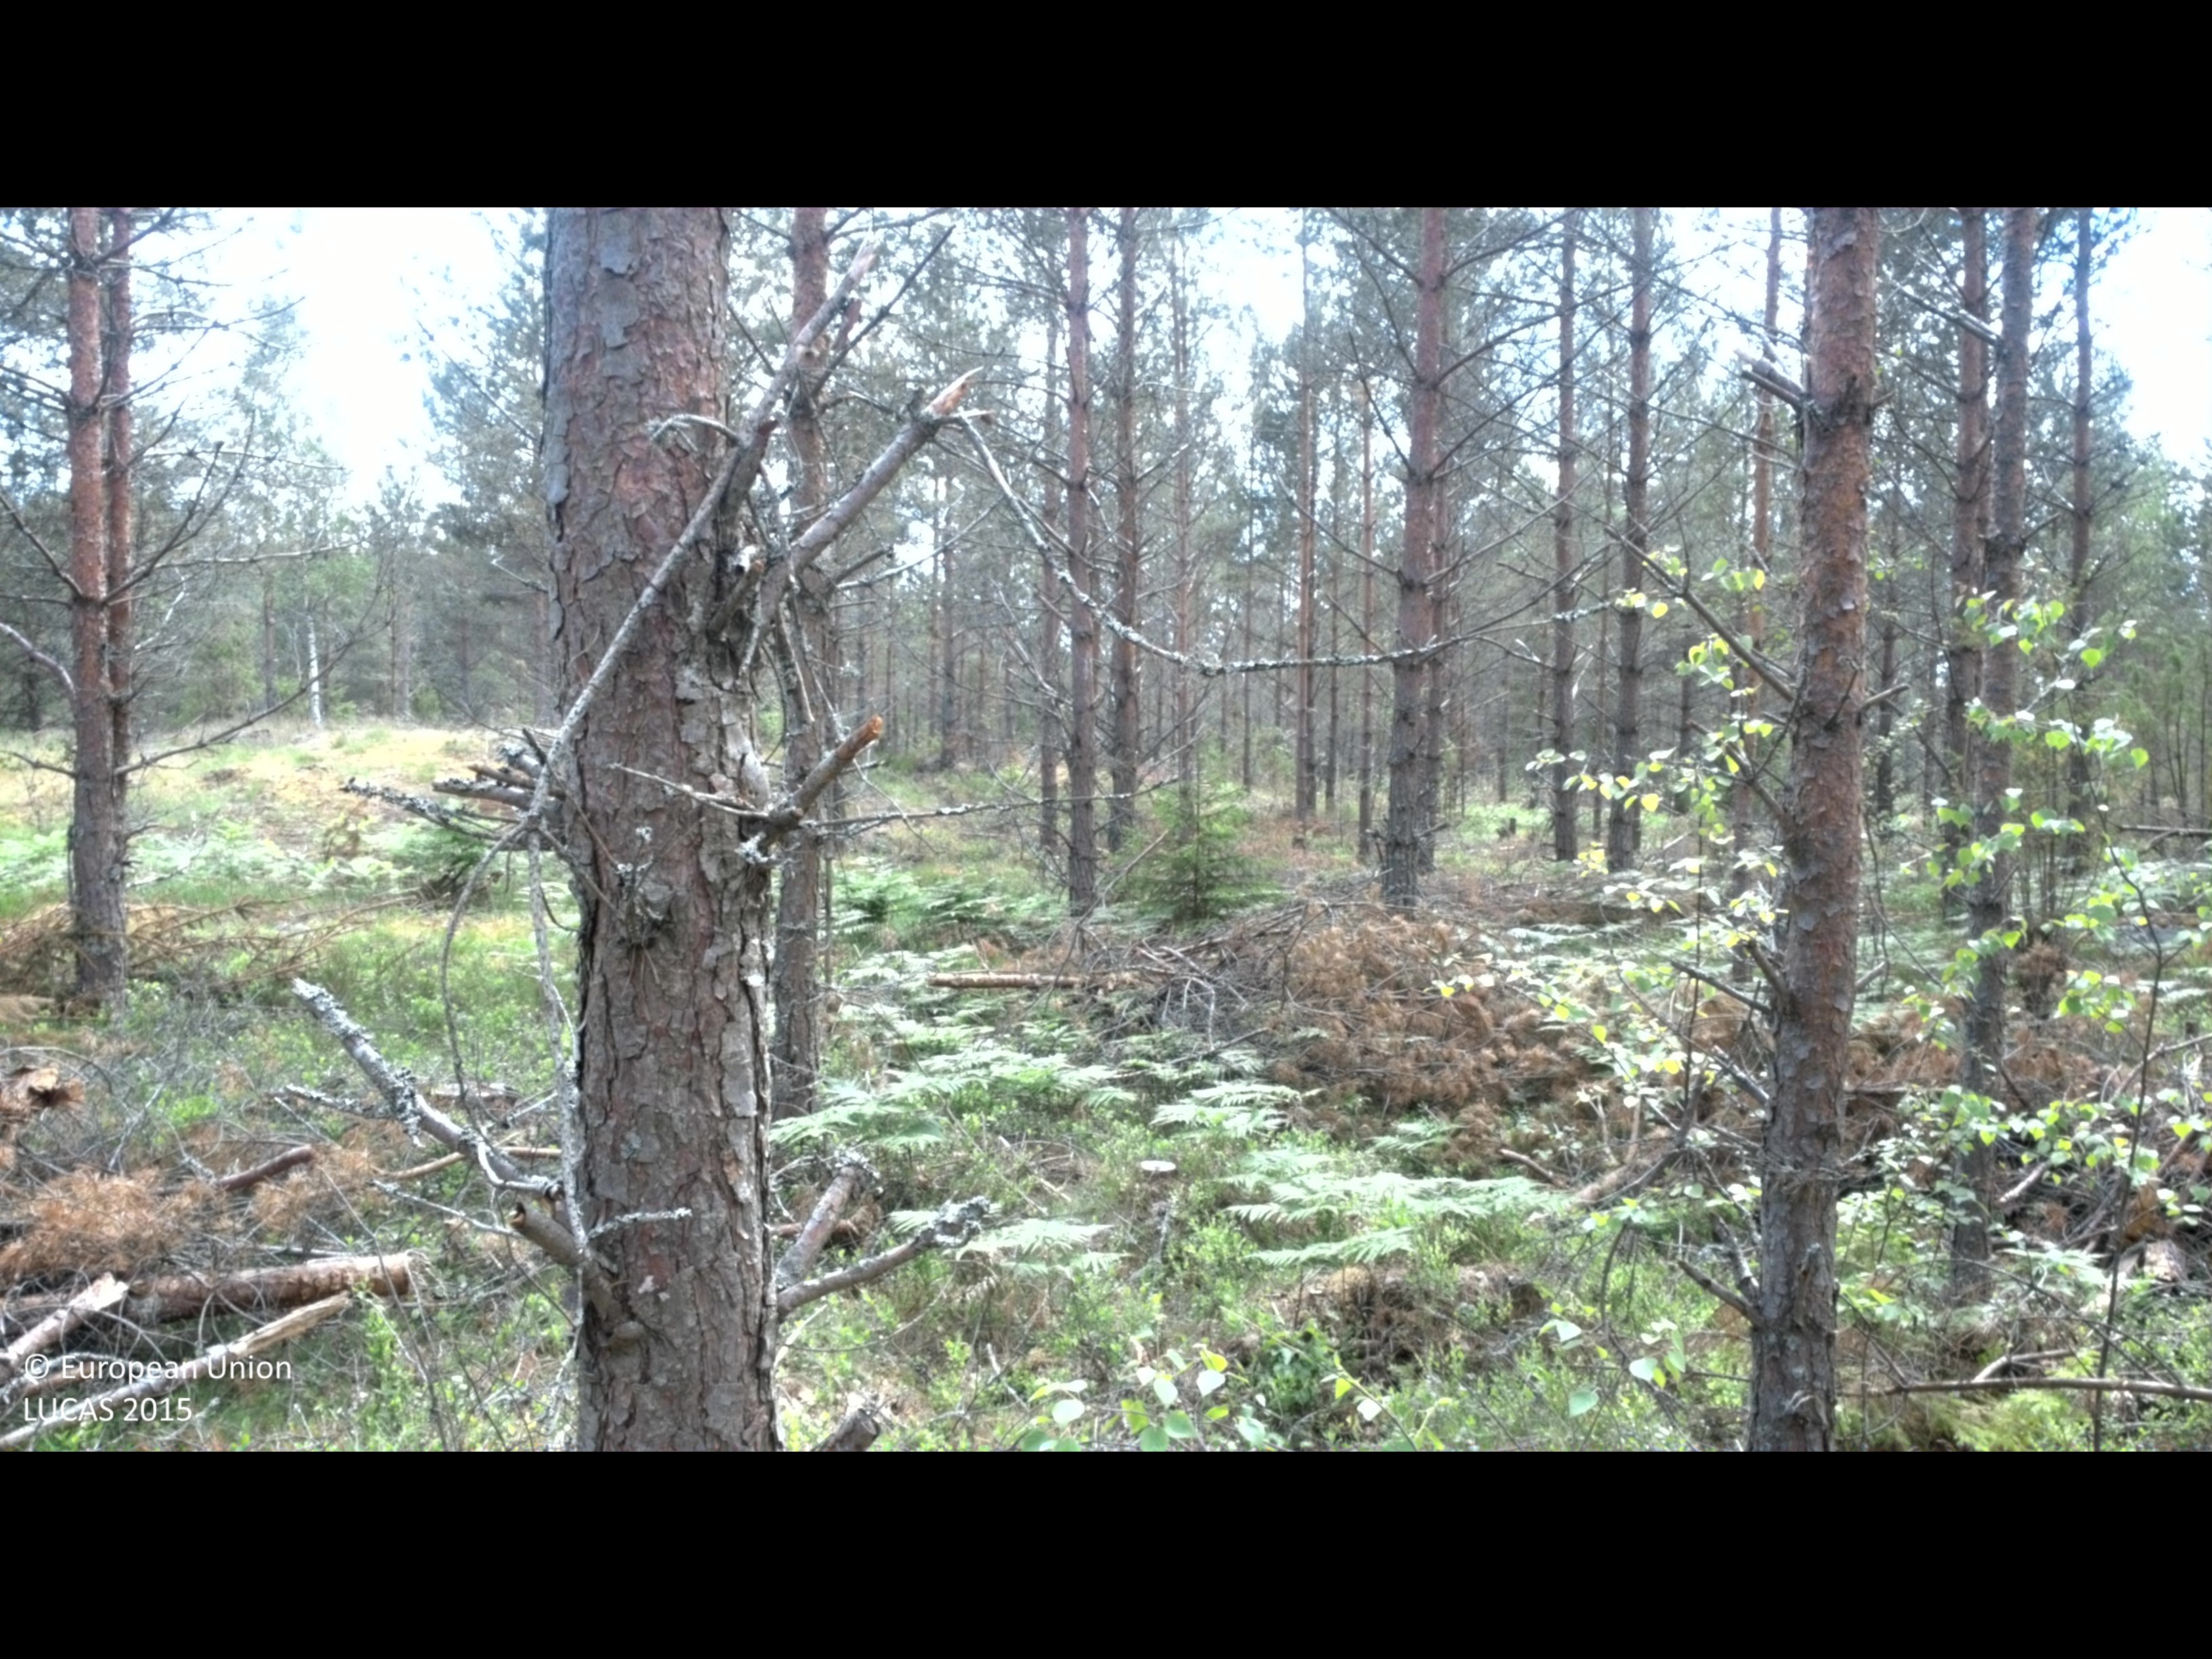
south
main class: Woodland
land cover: Pine dominated coniferous woodland
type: boreal forest
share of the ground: 50 - 75 %
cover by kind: coniferous forest trees 60 %, shrubs 20 %, herbaceous plants 10 %, broadleaved forest trees 5 %, unconsolidated bare surface 5 %
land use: Forestry
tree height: > 5 m
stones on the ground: < 10 %
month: June
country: SE
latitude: 57.7000
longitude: 16.5257
